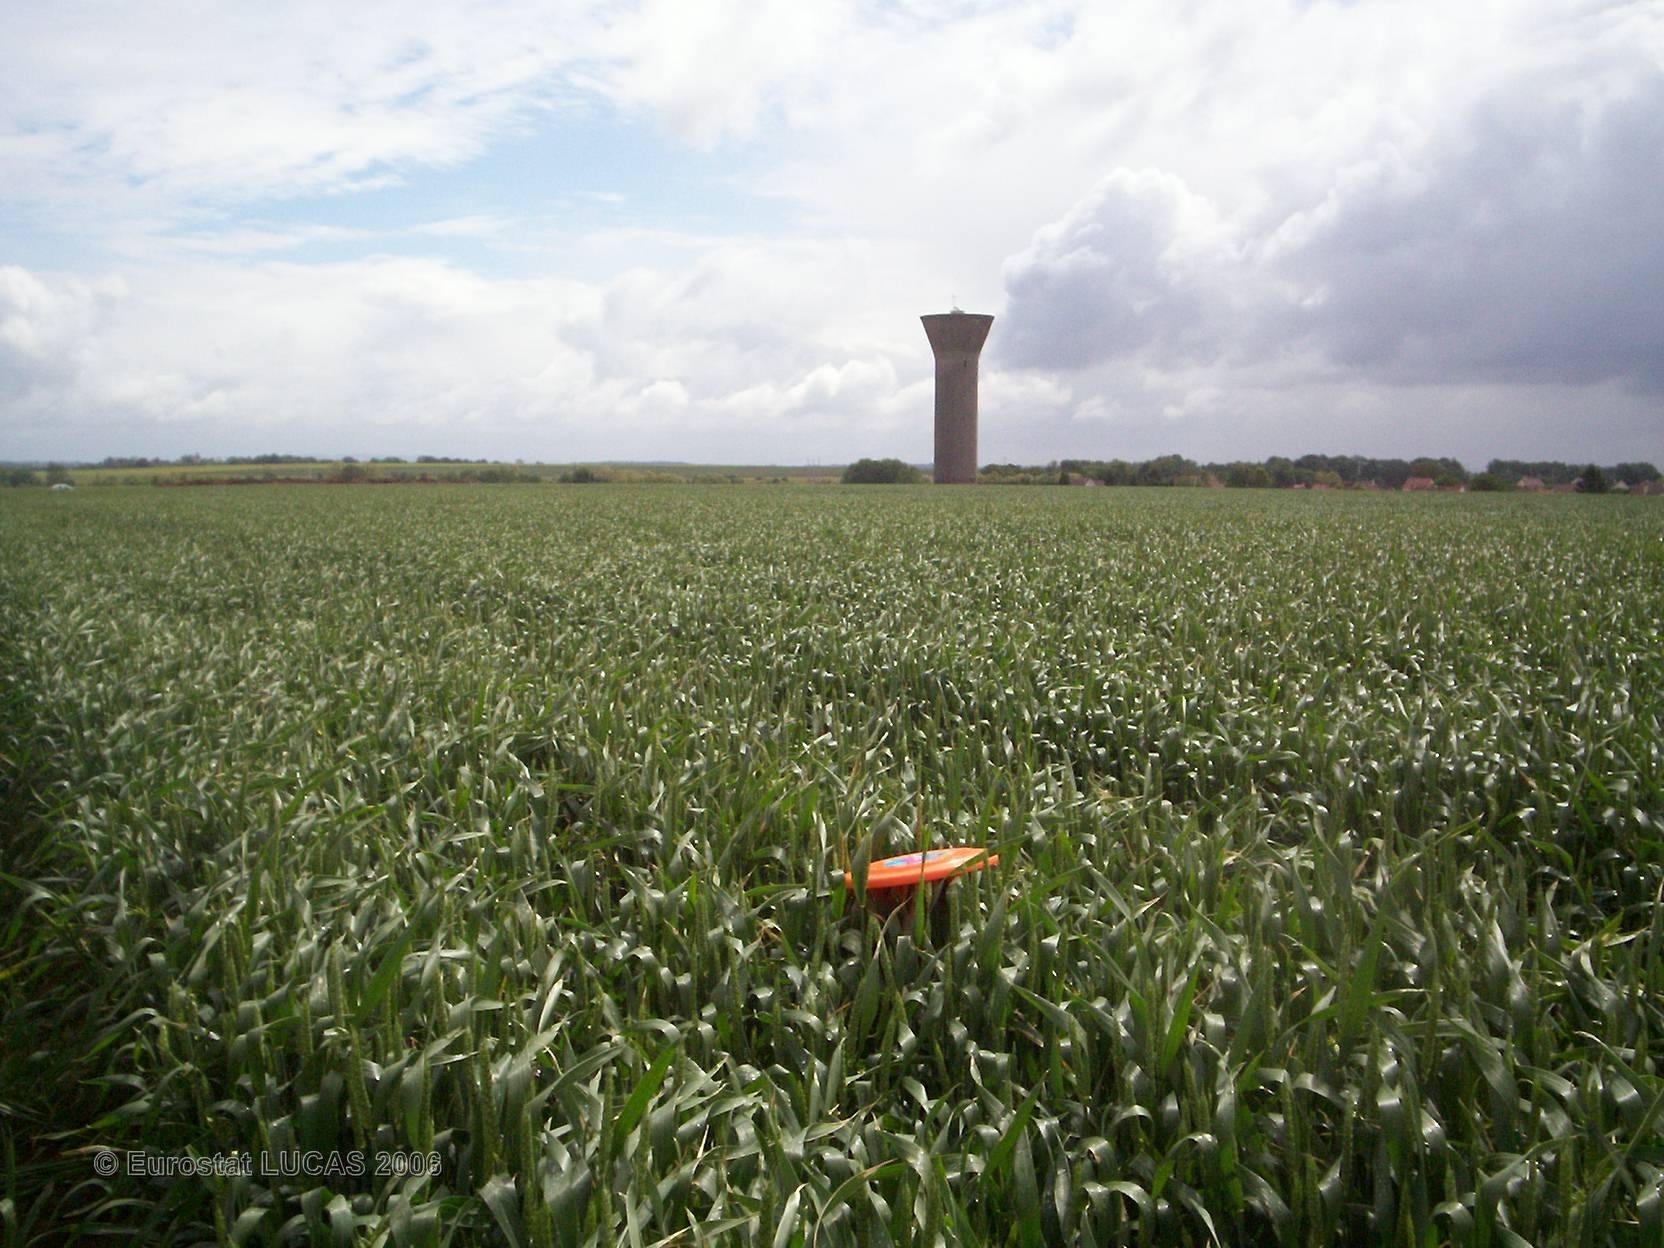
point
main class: Cropland
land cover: Common wheat
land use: Agriculture (excluding fallow land and kitchen gardens)
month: May
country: FR
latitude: 49.2866
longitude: 2.7719
